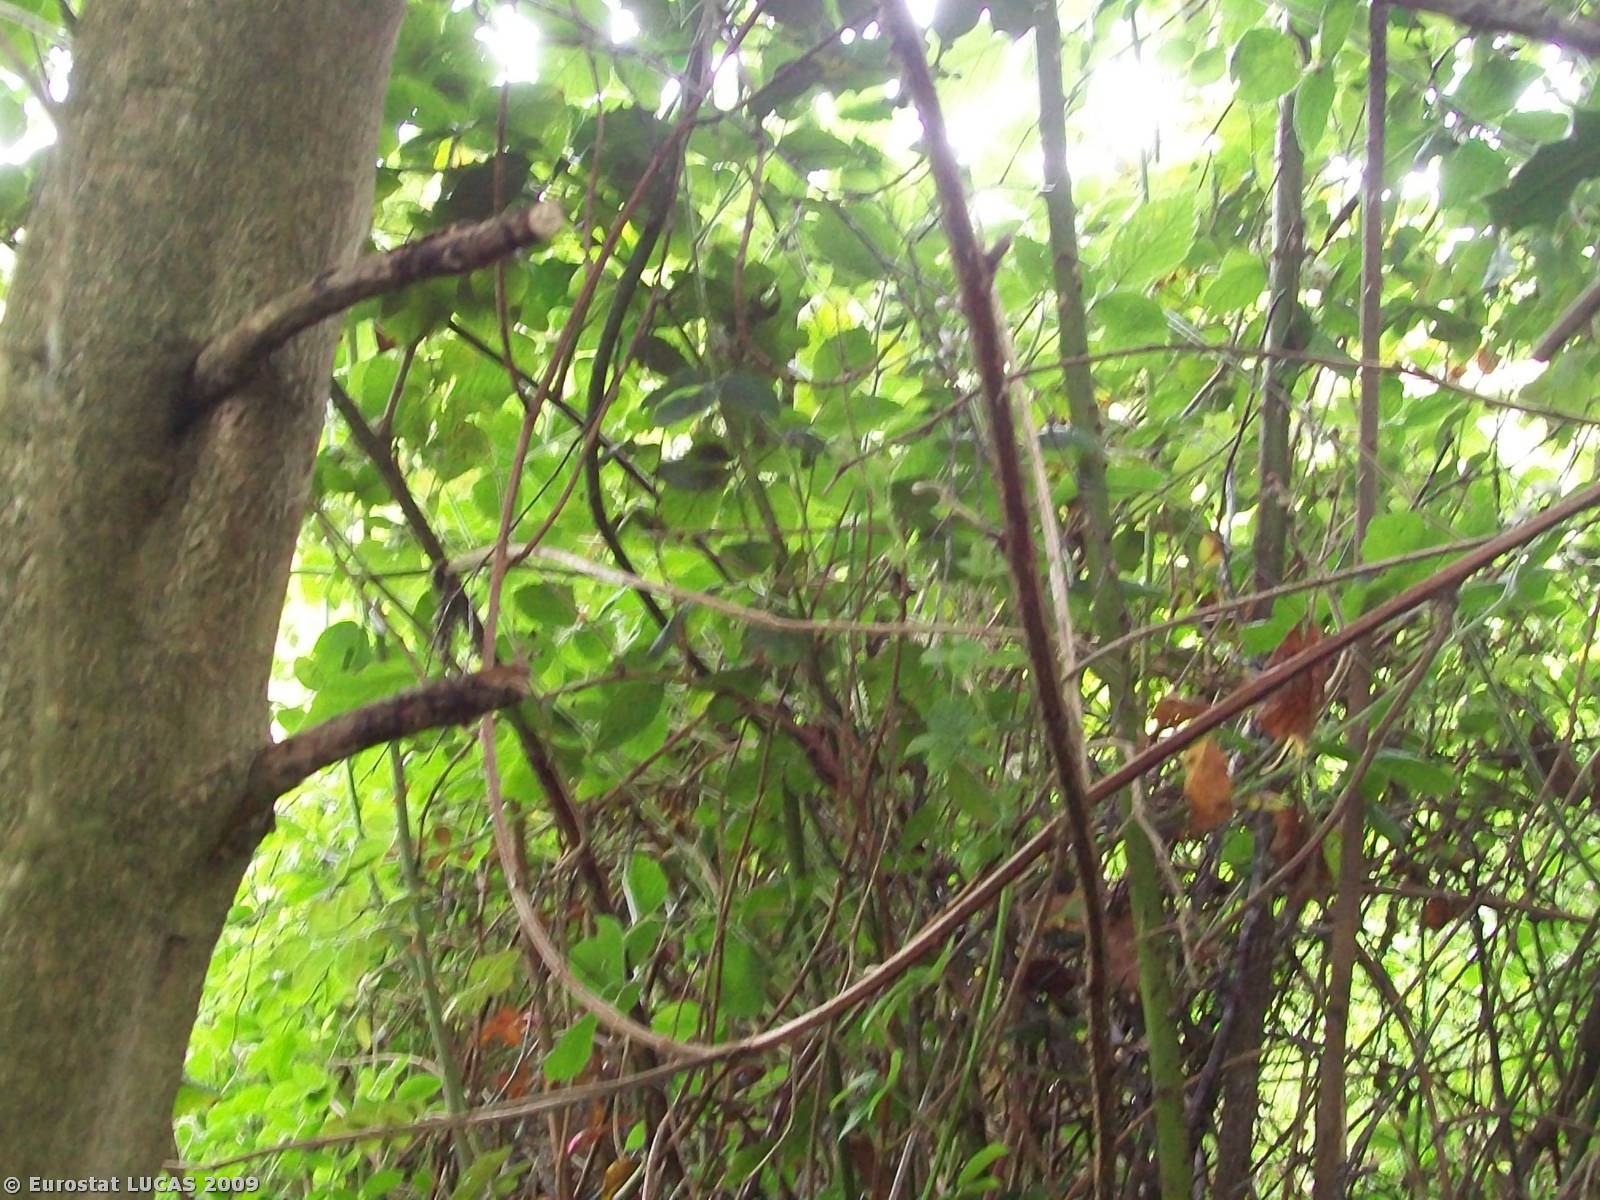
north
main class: Woodland
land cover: Broadleaved woodland
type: mesophytic deciduous forest
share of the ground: > 75 %
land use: Forestry
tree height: > 5 m
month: July
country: GB
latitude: 54.7840
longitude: -6.7213
